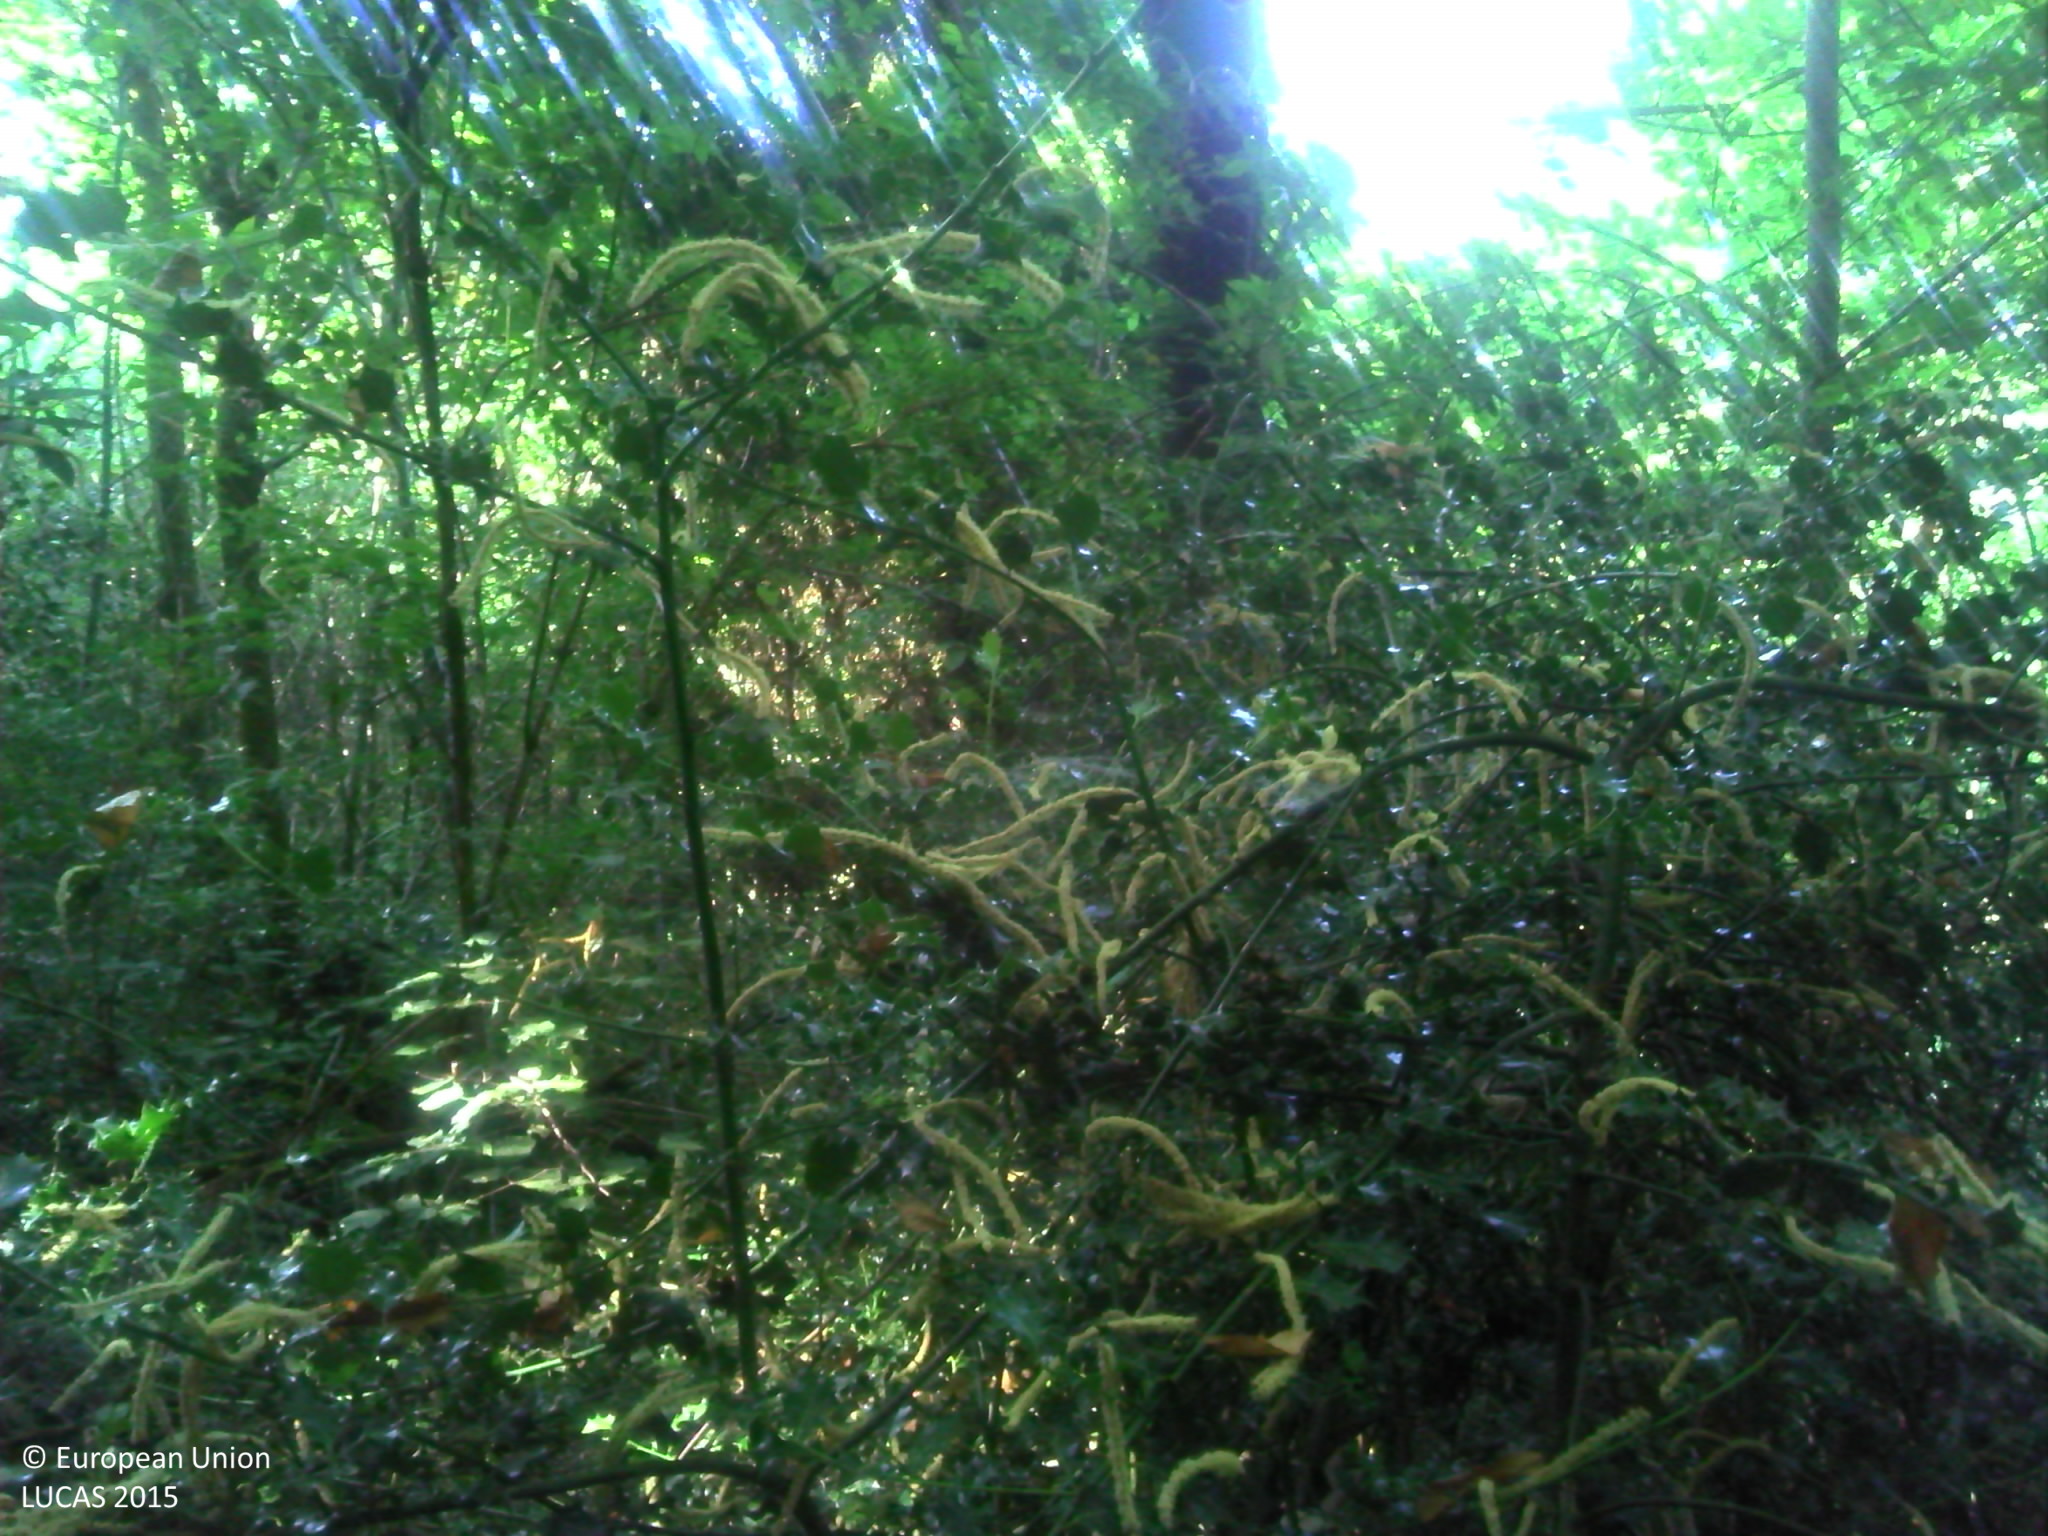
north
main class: Woodland
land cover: Broadleaved woodland
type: mesophytic deciduous forest
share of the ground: > 75 %
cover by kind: broadleaved forest trees 100 %
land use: Forestry
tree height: > 5 m
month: July
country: FR
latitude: 46.2694
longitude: 1.5438
